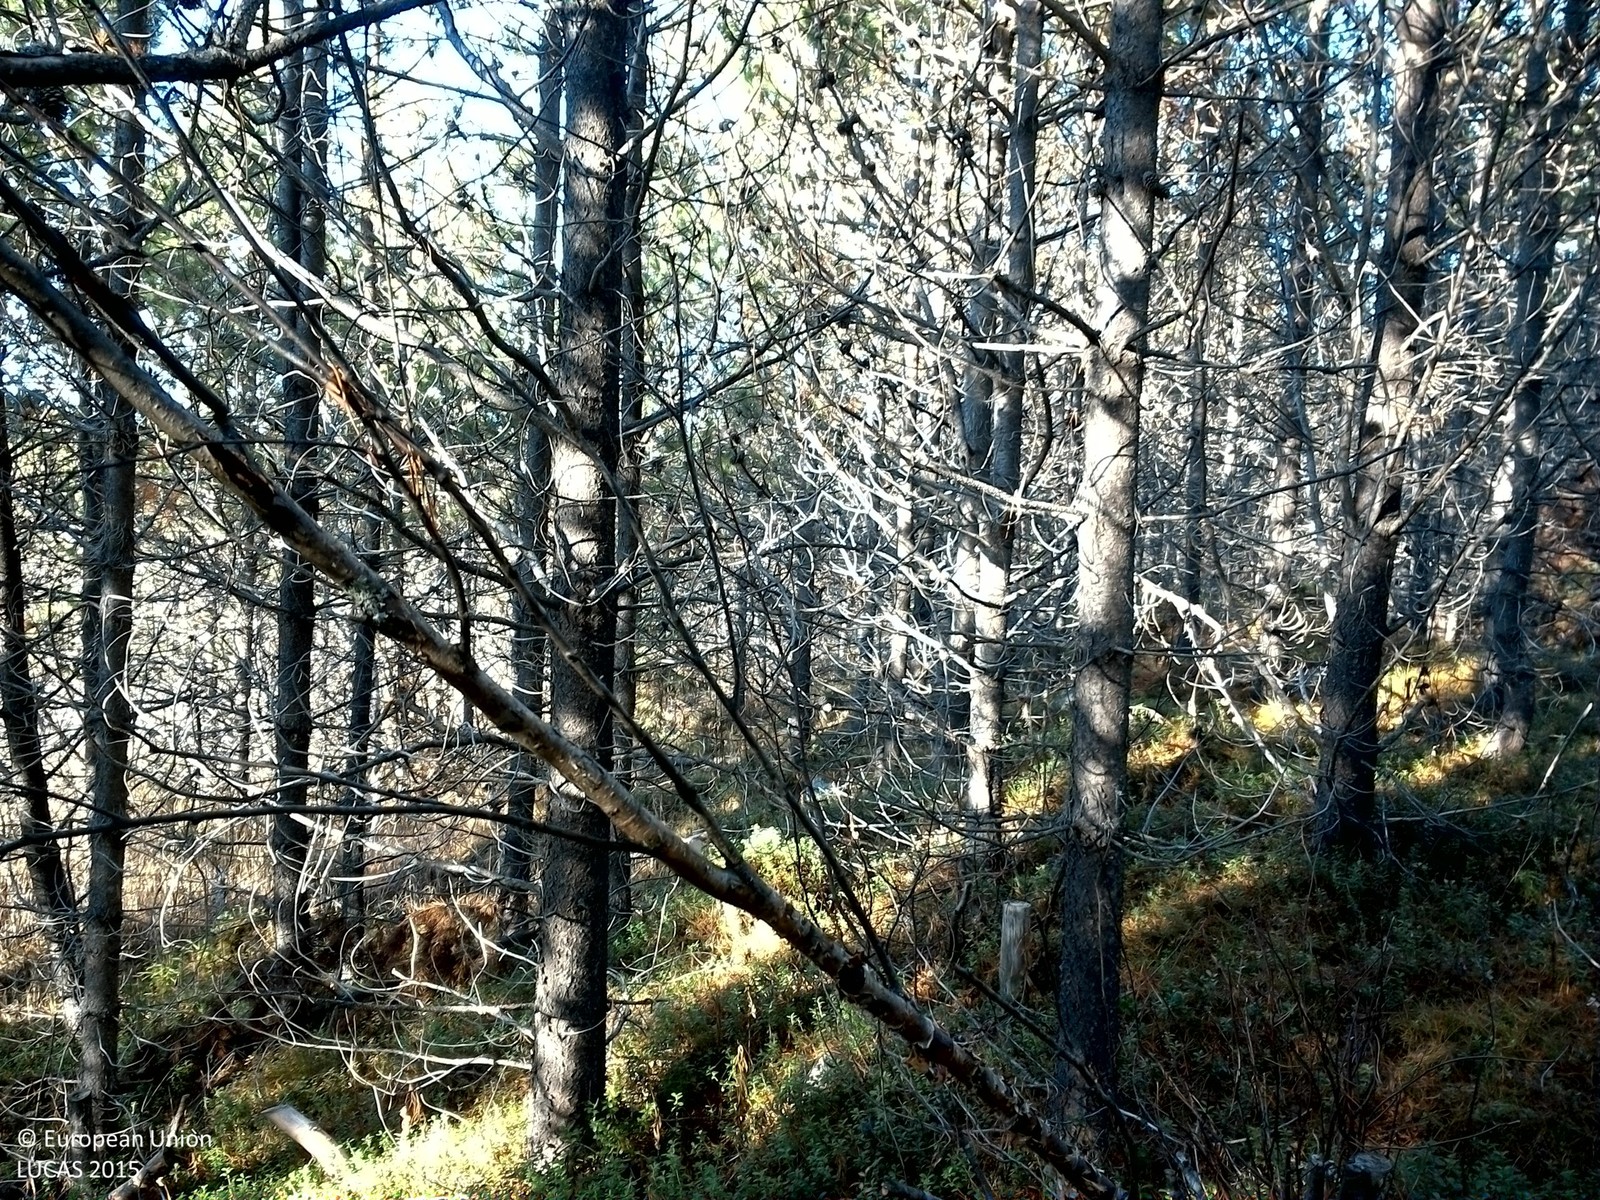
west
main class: Woodland
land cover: Pine dominated coniferous woodland
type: exotic forest
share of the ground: 25 - 50 %
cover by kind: coniferous forest trees 40 %, shrubs 35 %, lichens and mosses 20 %, herbaceous plants 5 %
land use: Forestry
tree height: > 5 m
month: October
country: SE
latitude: 64.4664
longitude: 15.4805
